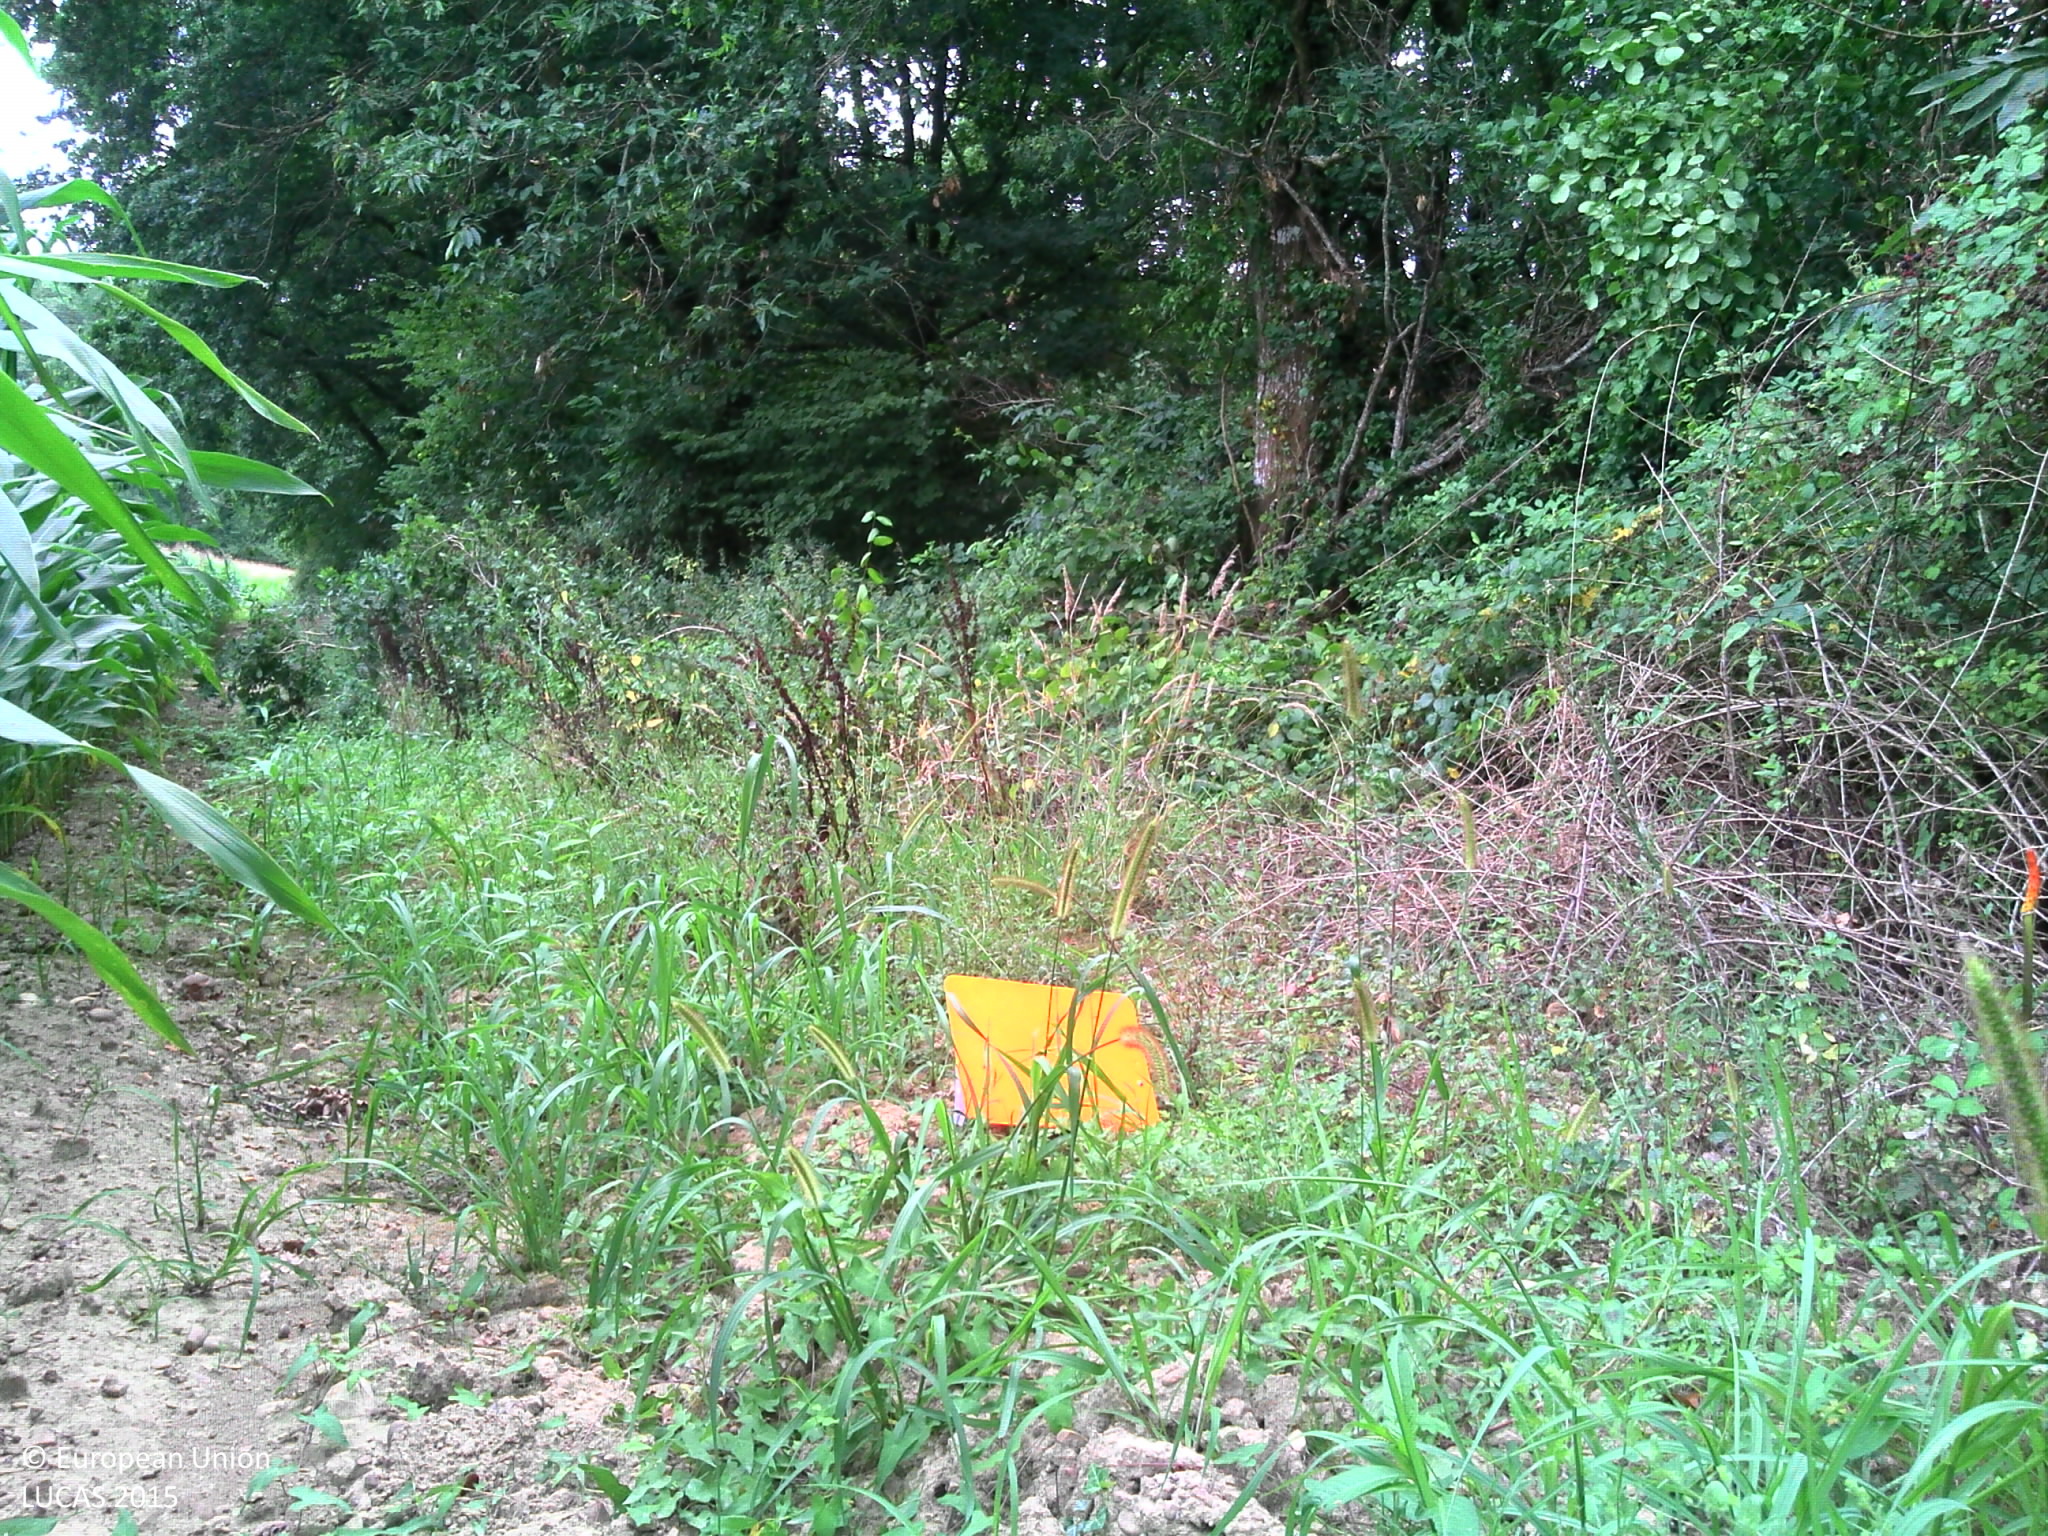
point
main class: Cropland
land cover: Maize
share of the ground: > 75 %
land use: Agriculture (excluding fallow land and kitchen gardens)
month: August
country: FR
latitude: 43.4824
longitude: -1.0800
